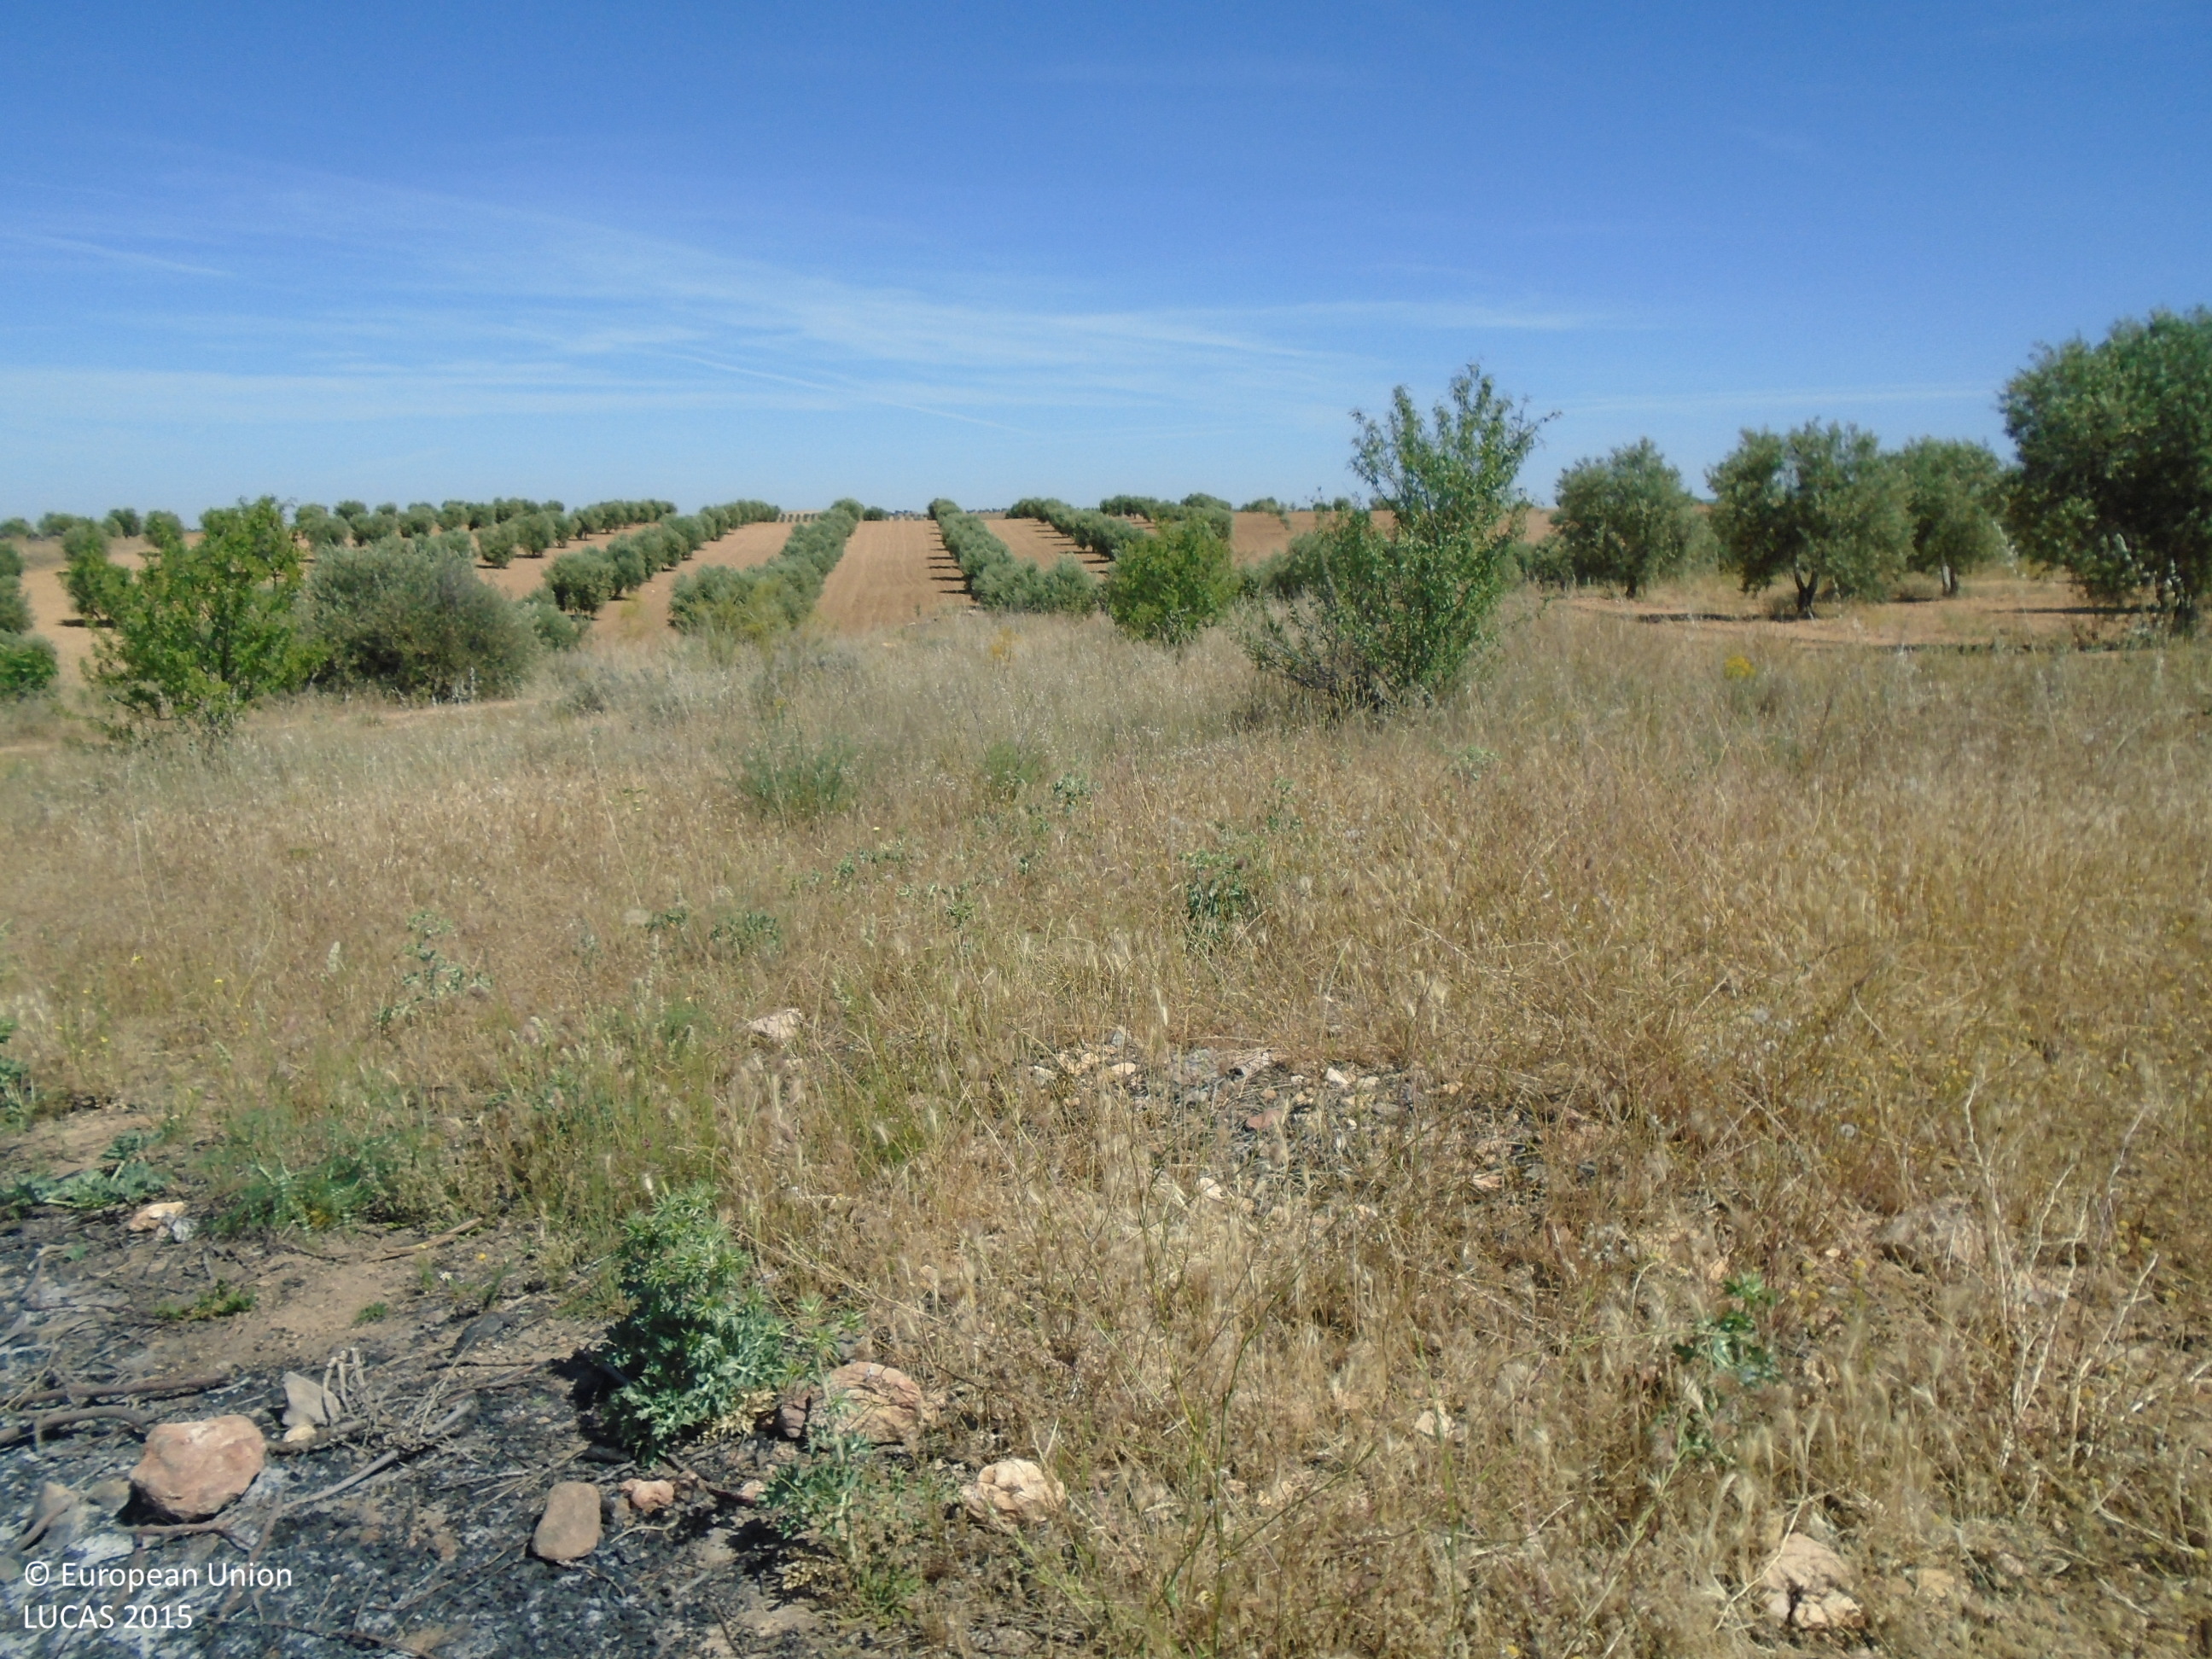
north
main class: Grassland
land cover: Grassland without tree/shrub cover
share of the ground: > 75 %
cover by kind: herbaceous plants 95 %, shrubs 5 %
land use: Abandoned areas
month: May
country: ES
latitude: 39.8098
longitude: -3.7315
